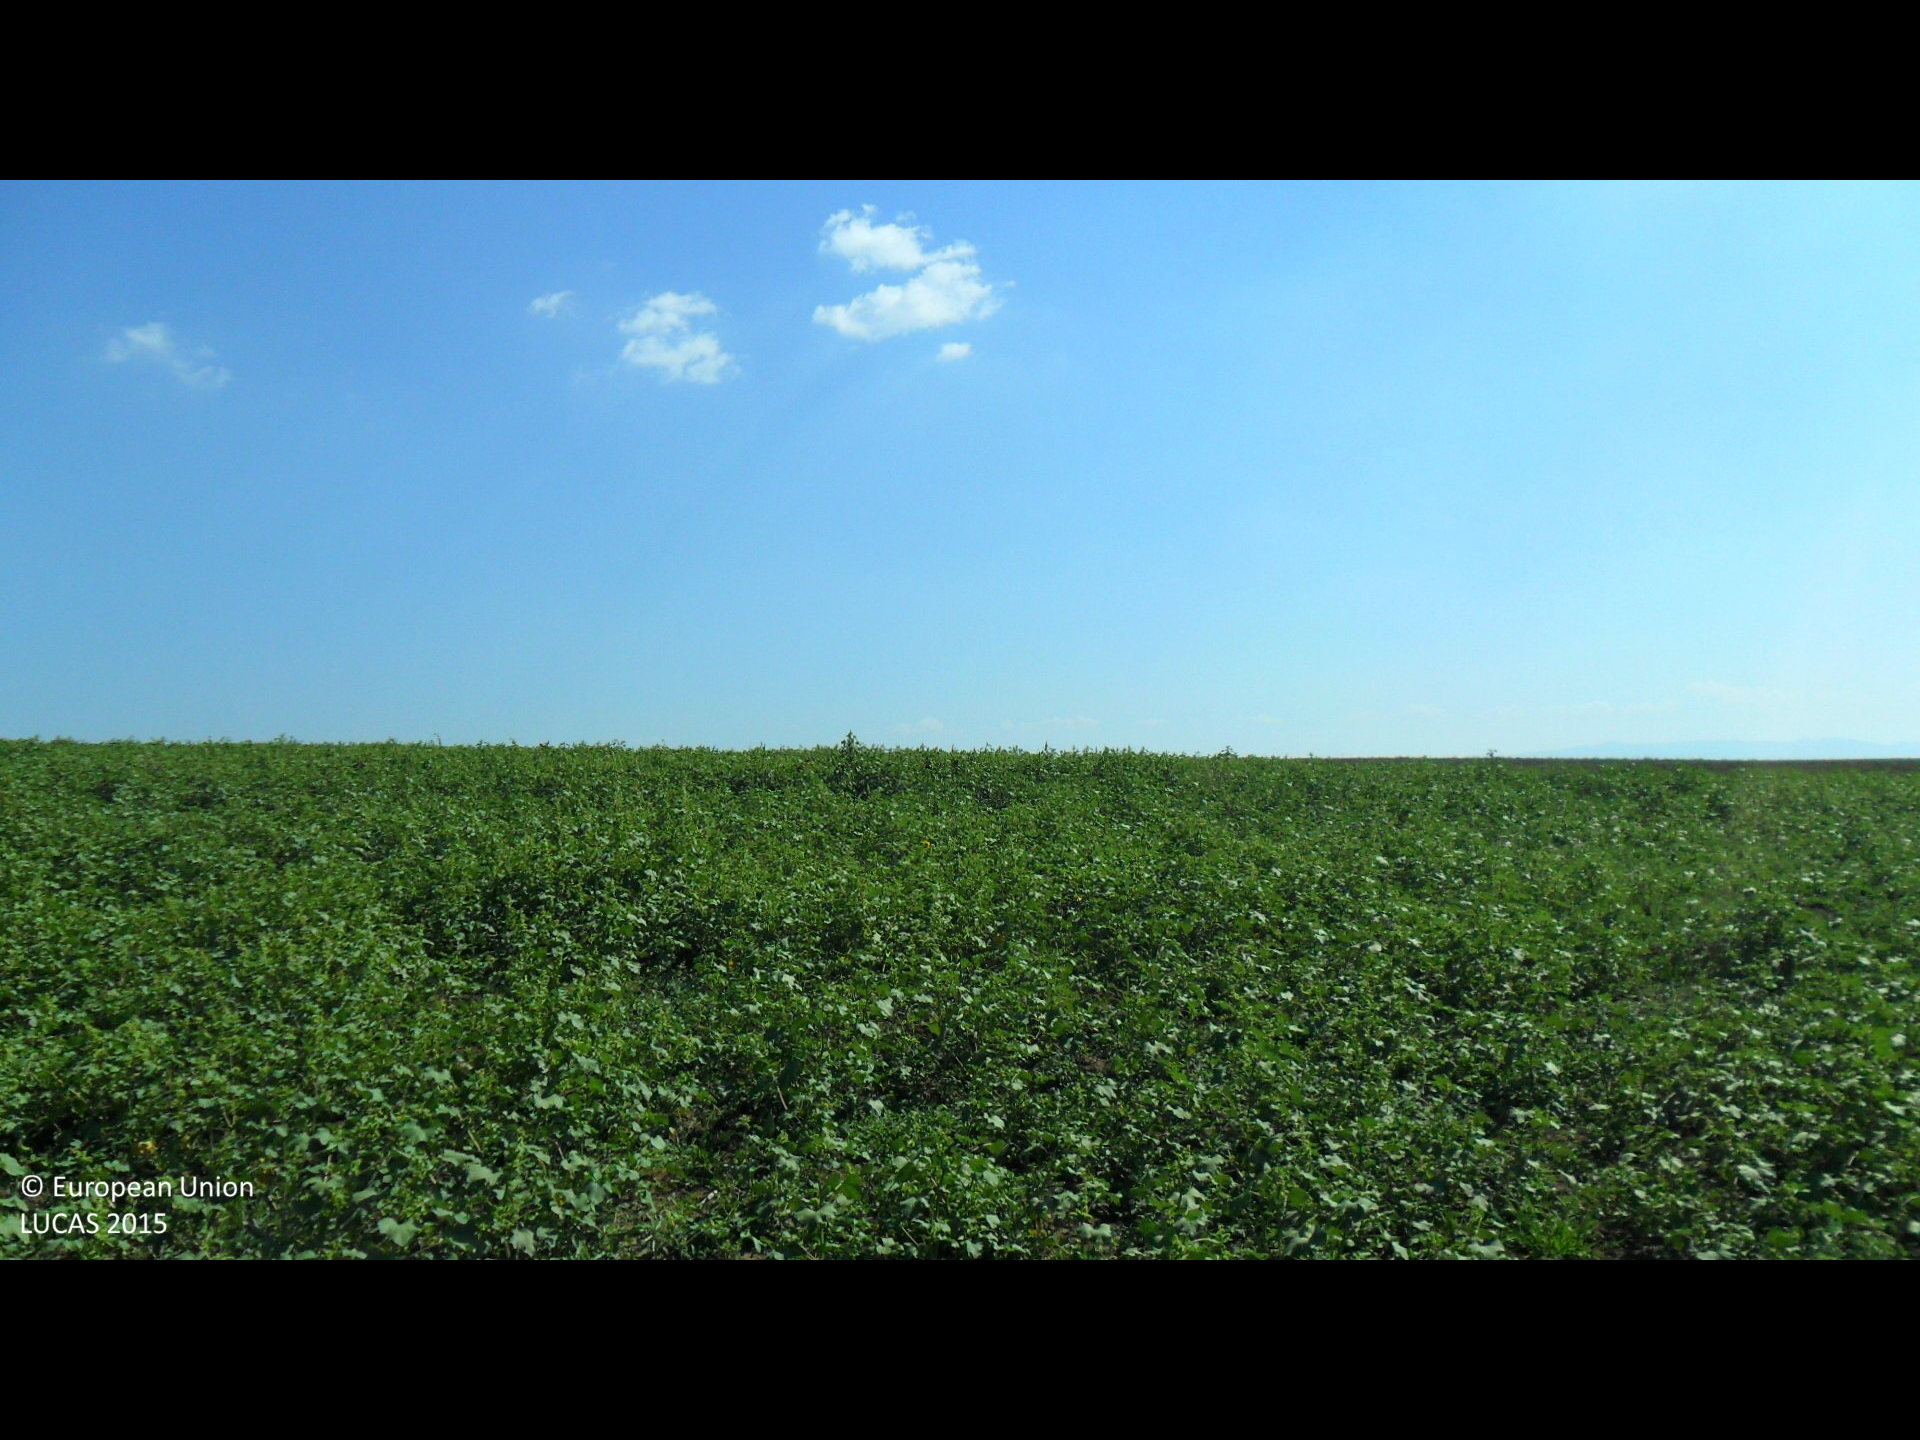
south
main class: Grassland
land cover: Spontaneously vegetated surfaces
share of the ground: > 75 %
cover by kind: herbaceous plants 100 %
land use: Fallow land
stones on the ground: < 10 %
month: August
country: BG
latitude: 43.2307
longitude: 26.4392
